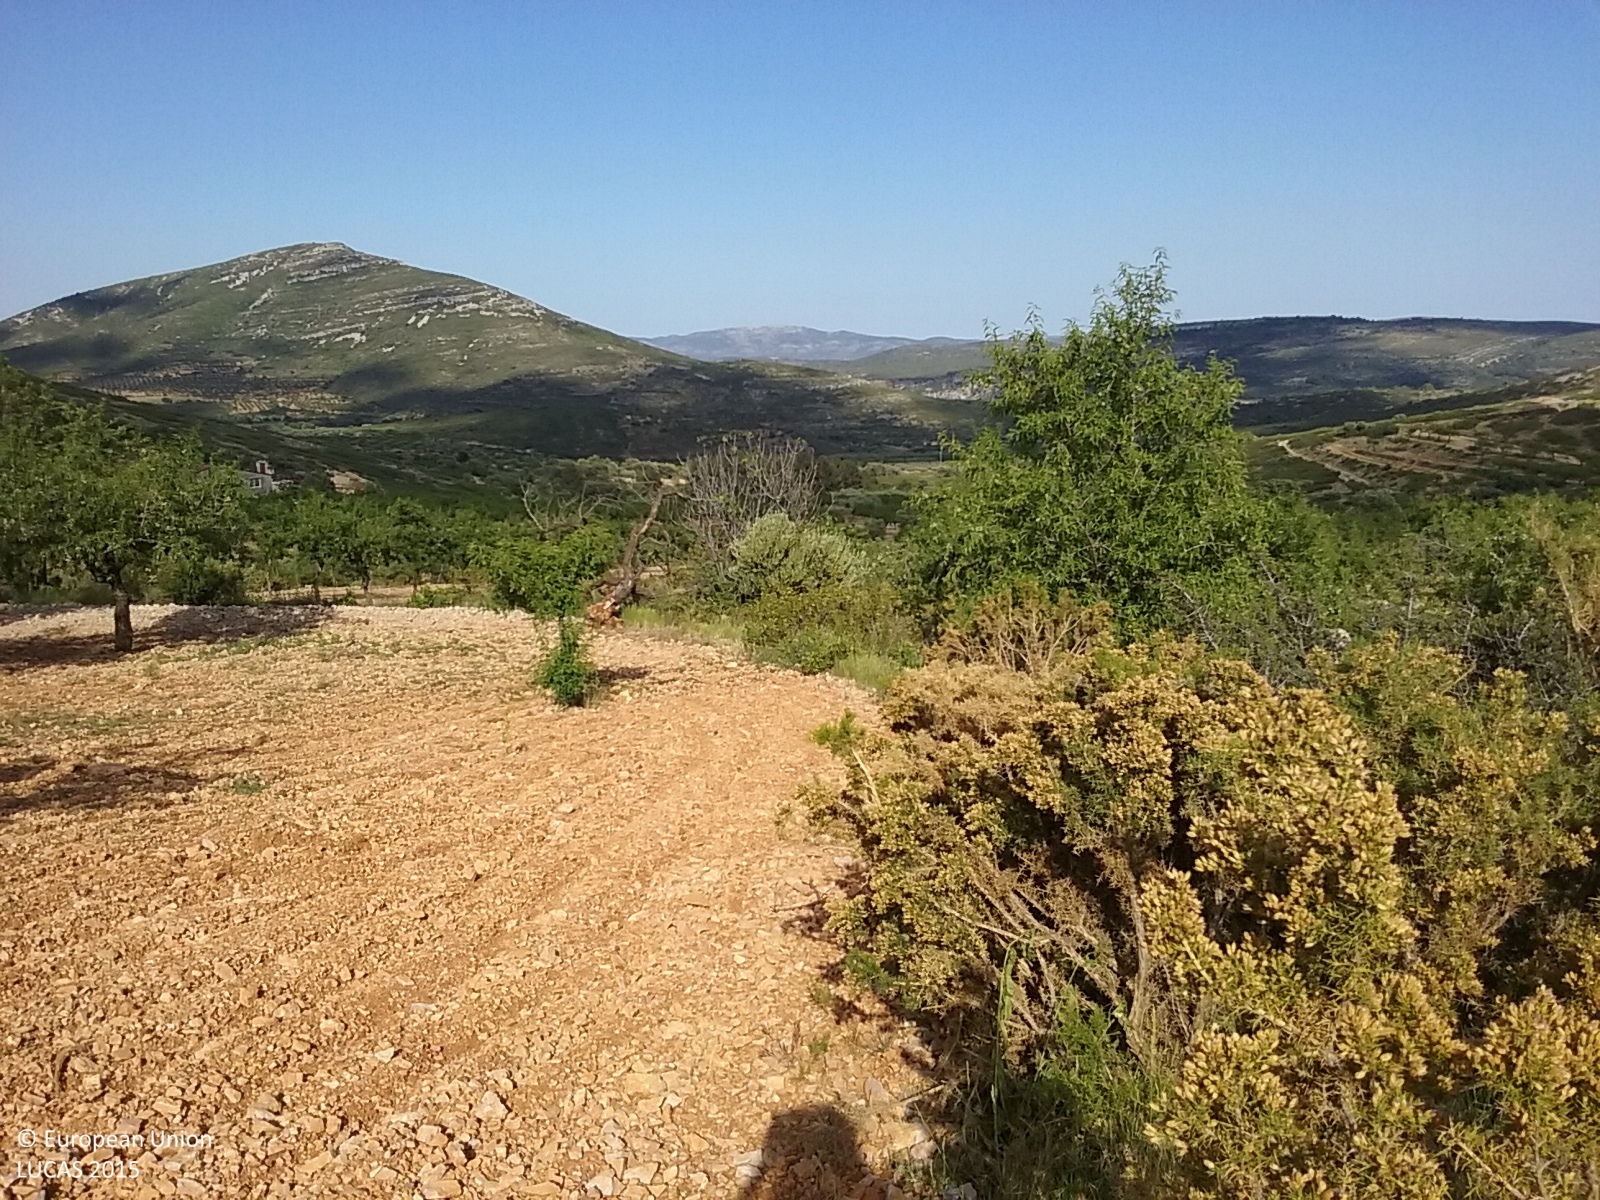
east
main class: Cropland
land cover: Nuts trees
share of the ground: < 10 %
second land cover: Other bare soil
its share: > 75 %
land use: Agriculture (excluding fallow land and kitchen gardens)
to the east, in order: Nuts trees; Shruby margins; Dry stone walls; Nuts trees; Shrubland without tree cover; Nuts trees; Shrubland with sparse tree cover; Nuts trees; Dry stone walls; Tracks; Shrubland with sparse tree cover; Nuts trees; Tracks; Nuts trees; Tracks; Nuts trees
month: May
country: ES
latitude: 40.3920
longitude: -0.0067
